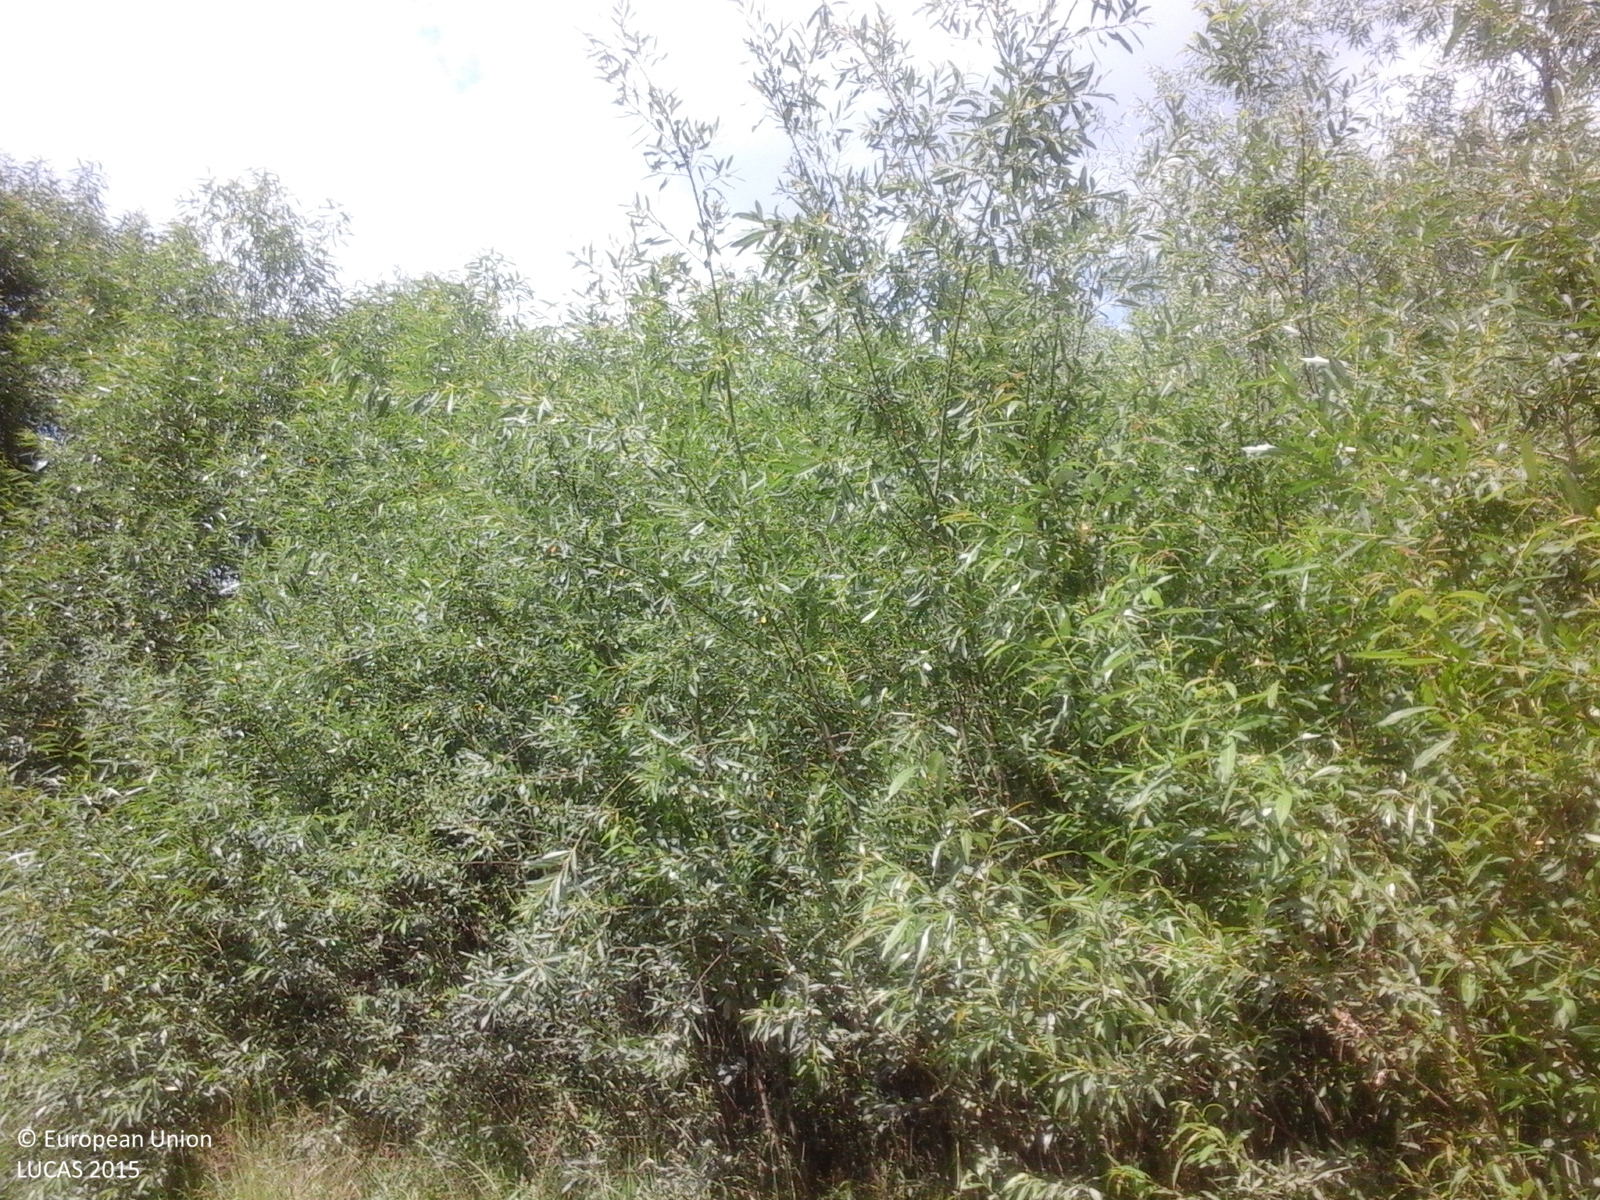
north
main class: Woodland
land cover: Broadleaved woodland
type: thermophilous deciduous forest
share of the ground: > 75 %
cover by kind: broadleaved forest trees 90 %, shrubs 10 %
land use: Semi-natural and natural areas not in use
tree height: > 5 m
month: June
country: RO
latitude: 47.8271
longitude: 25.7948
